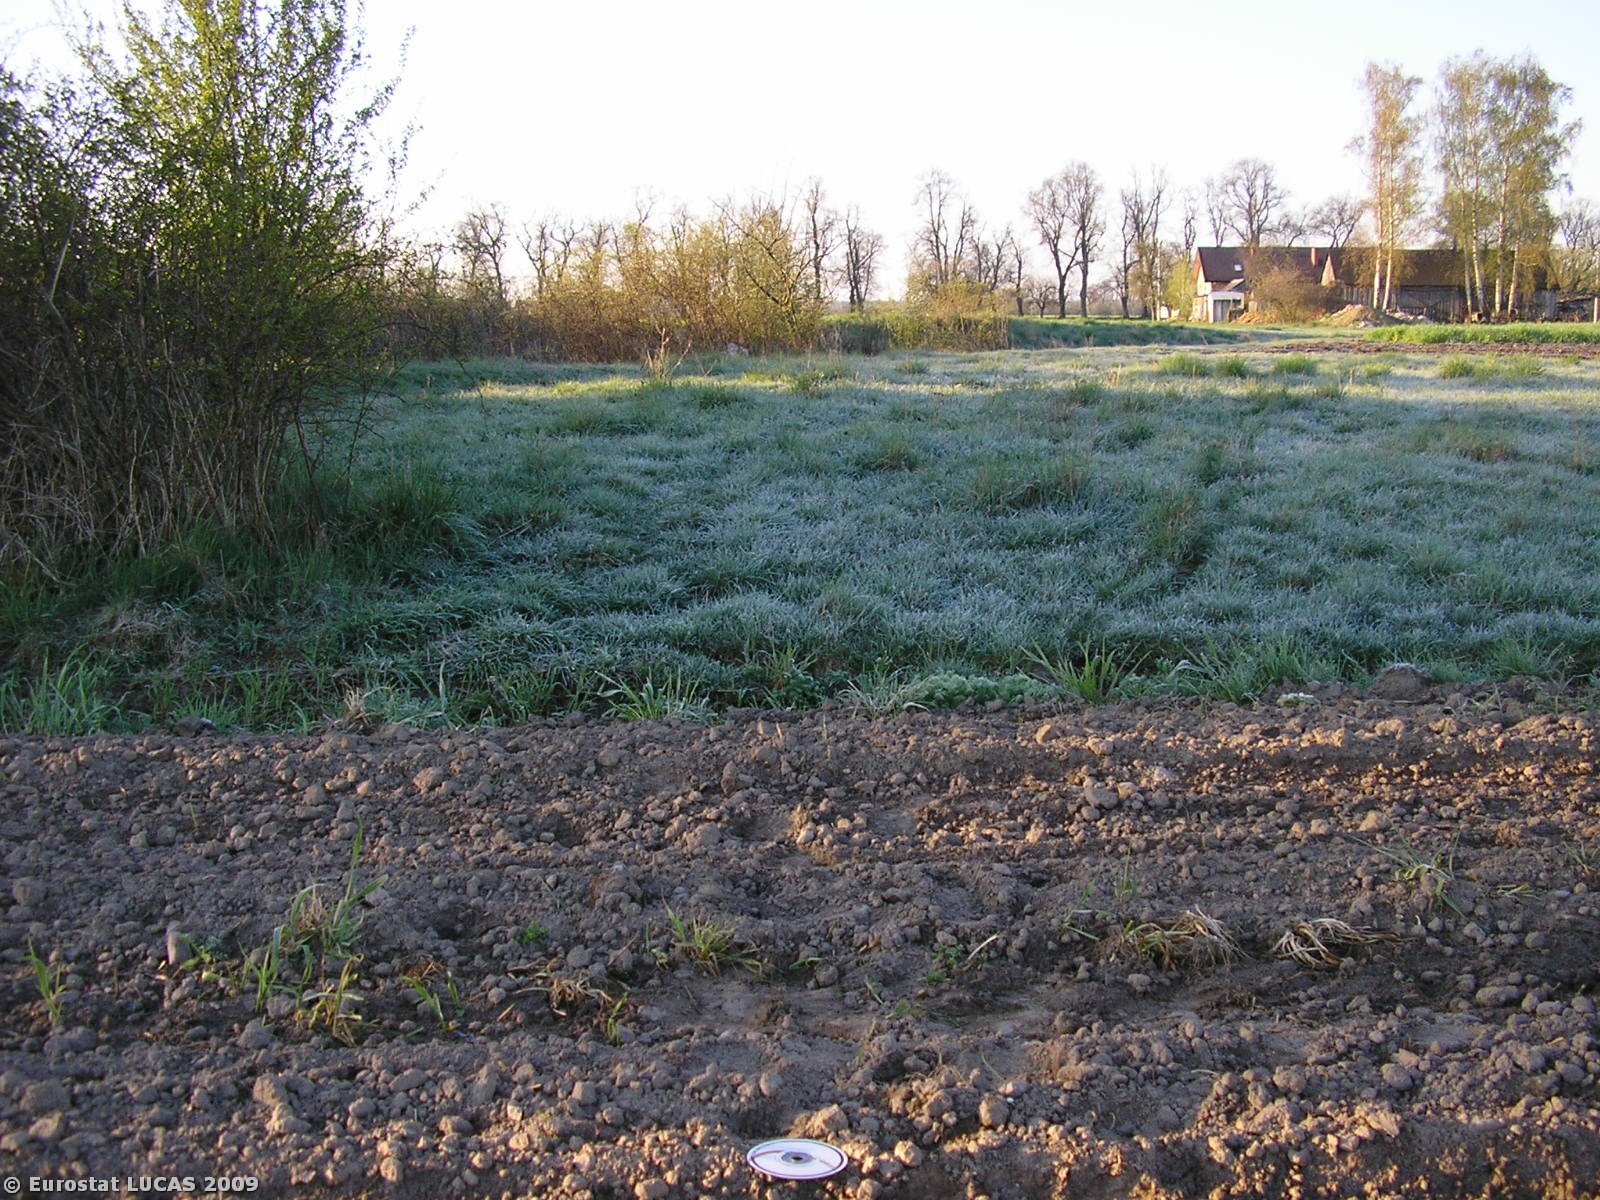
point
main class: Cropland
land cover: Other root crops
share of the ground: < 10 %
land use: Agriculture (excluding fallow land and kitchen gardens)
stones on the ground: < 10 %
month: April
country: PL
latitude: 52.0737
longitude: 20.0860
